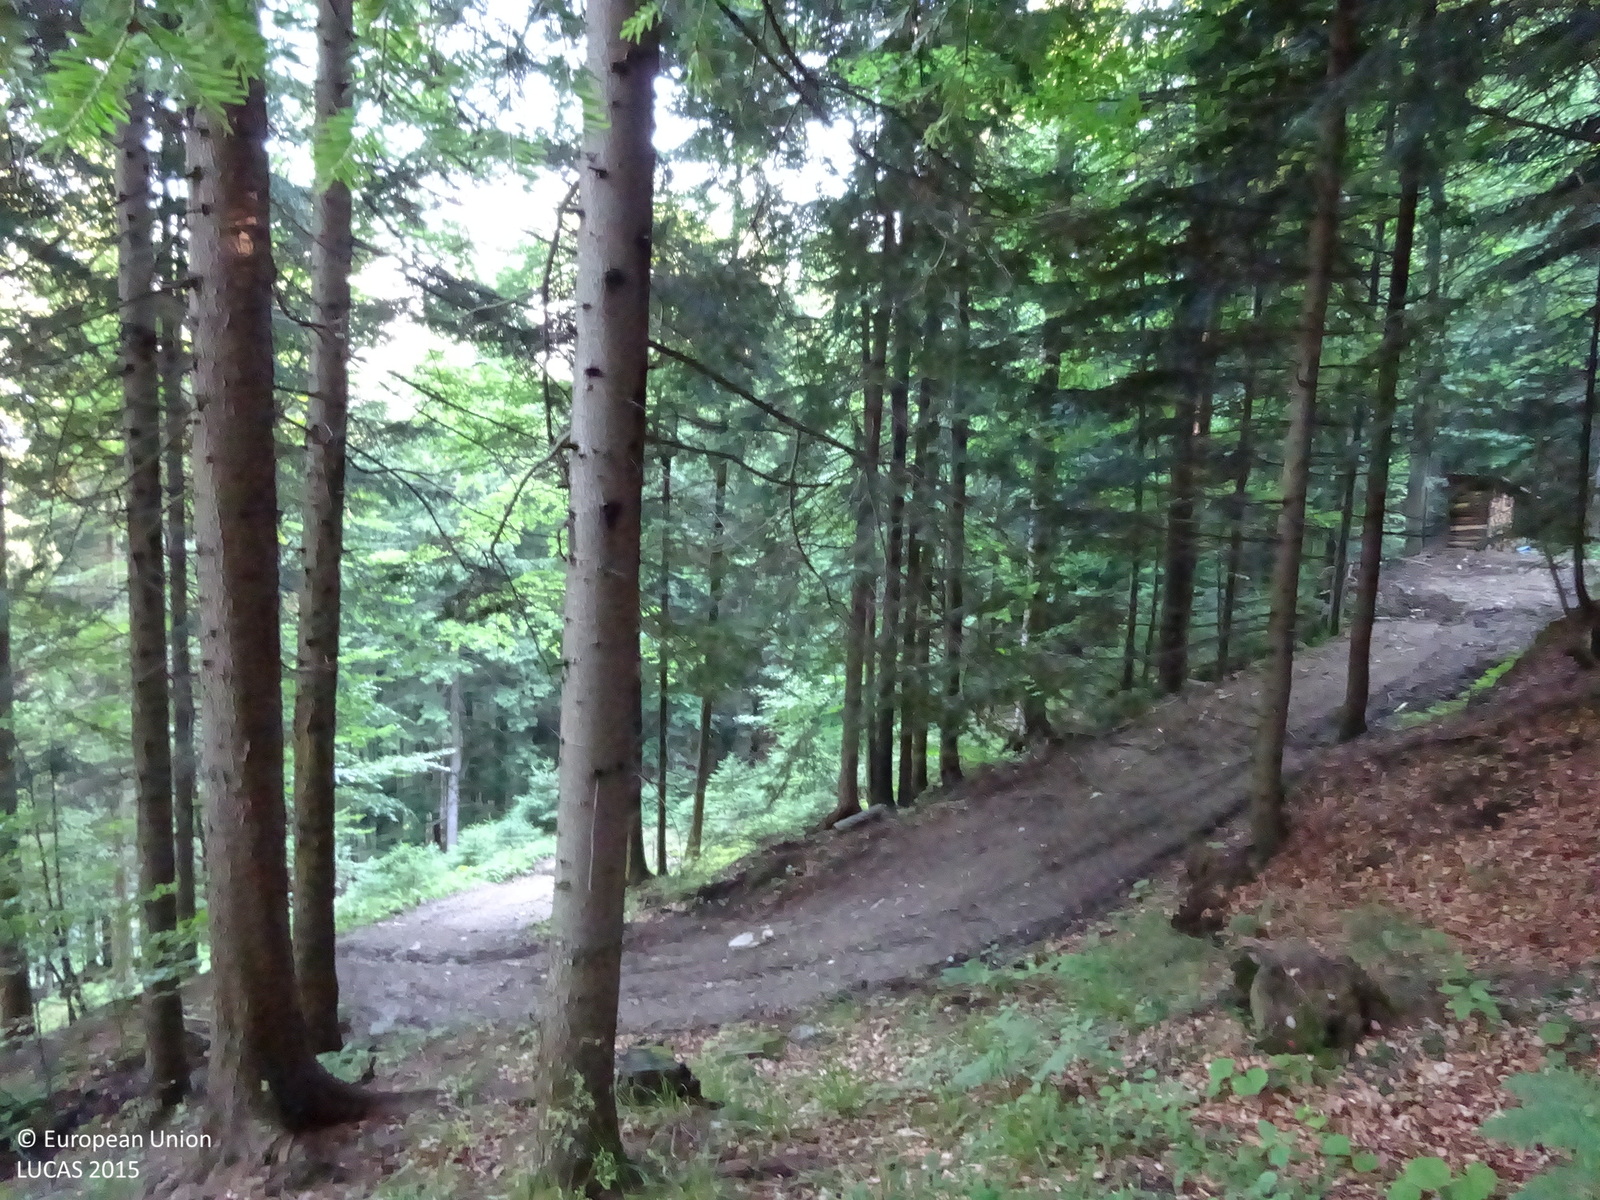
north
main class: Woodland
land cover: Spruce dominated mixed woodland
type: mountainous beech forest
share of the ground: > 75 %
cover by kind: broadleaved forest trees 60 %, coniferous forest trees 30 %, herbaceous plants 5 %, lichens and mosses 5 %
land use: Forestry
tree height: > 5 m
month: June
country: AT
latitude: 46.6534
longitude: 15.2908
